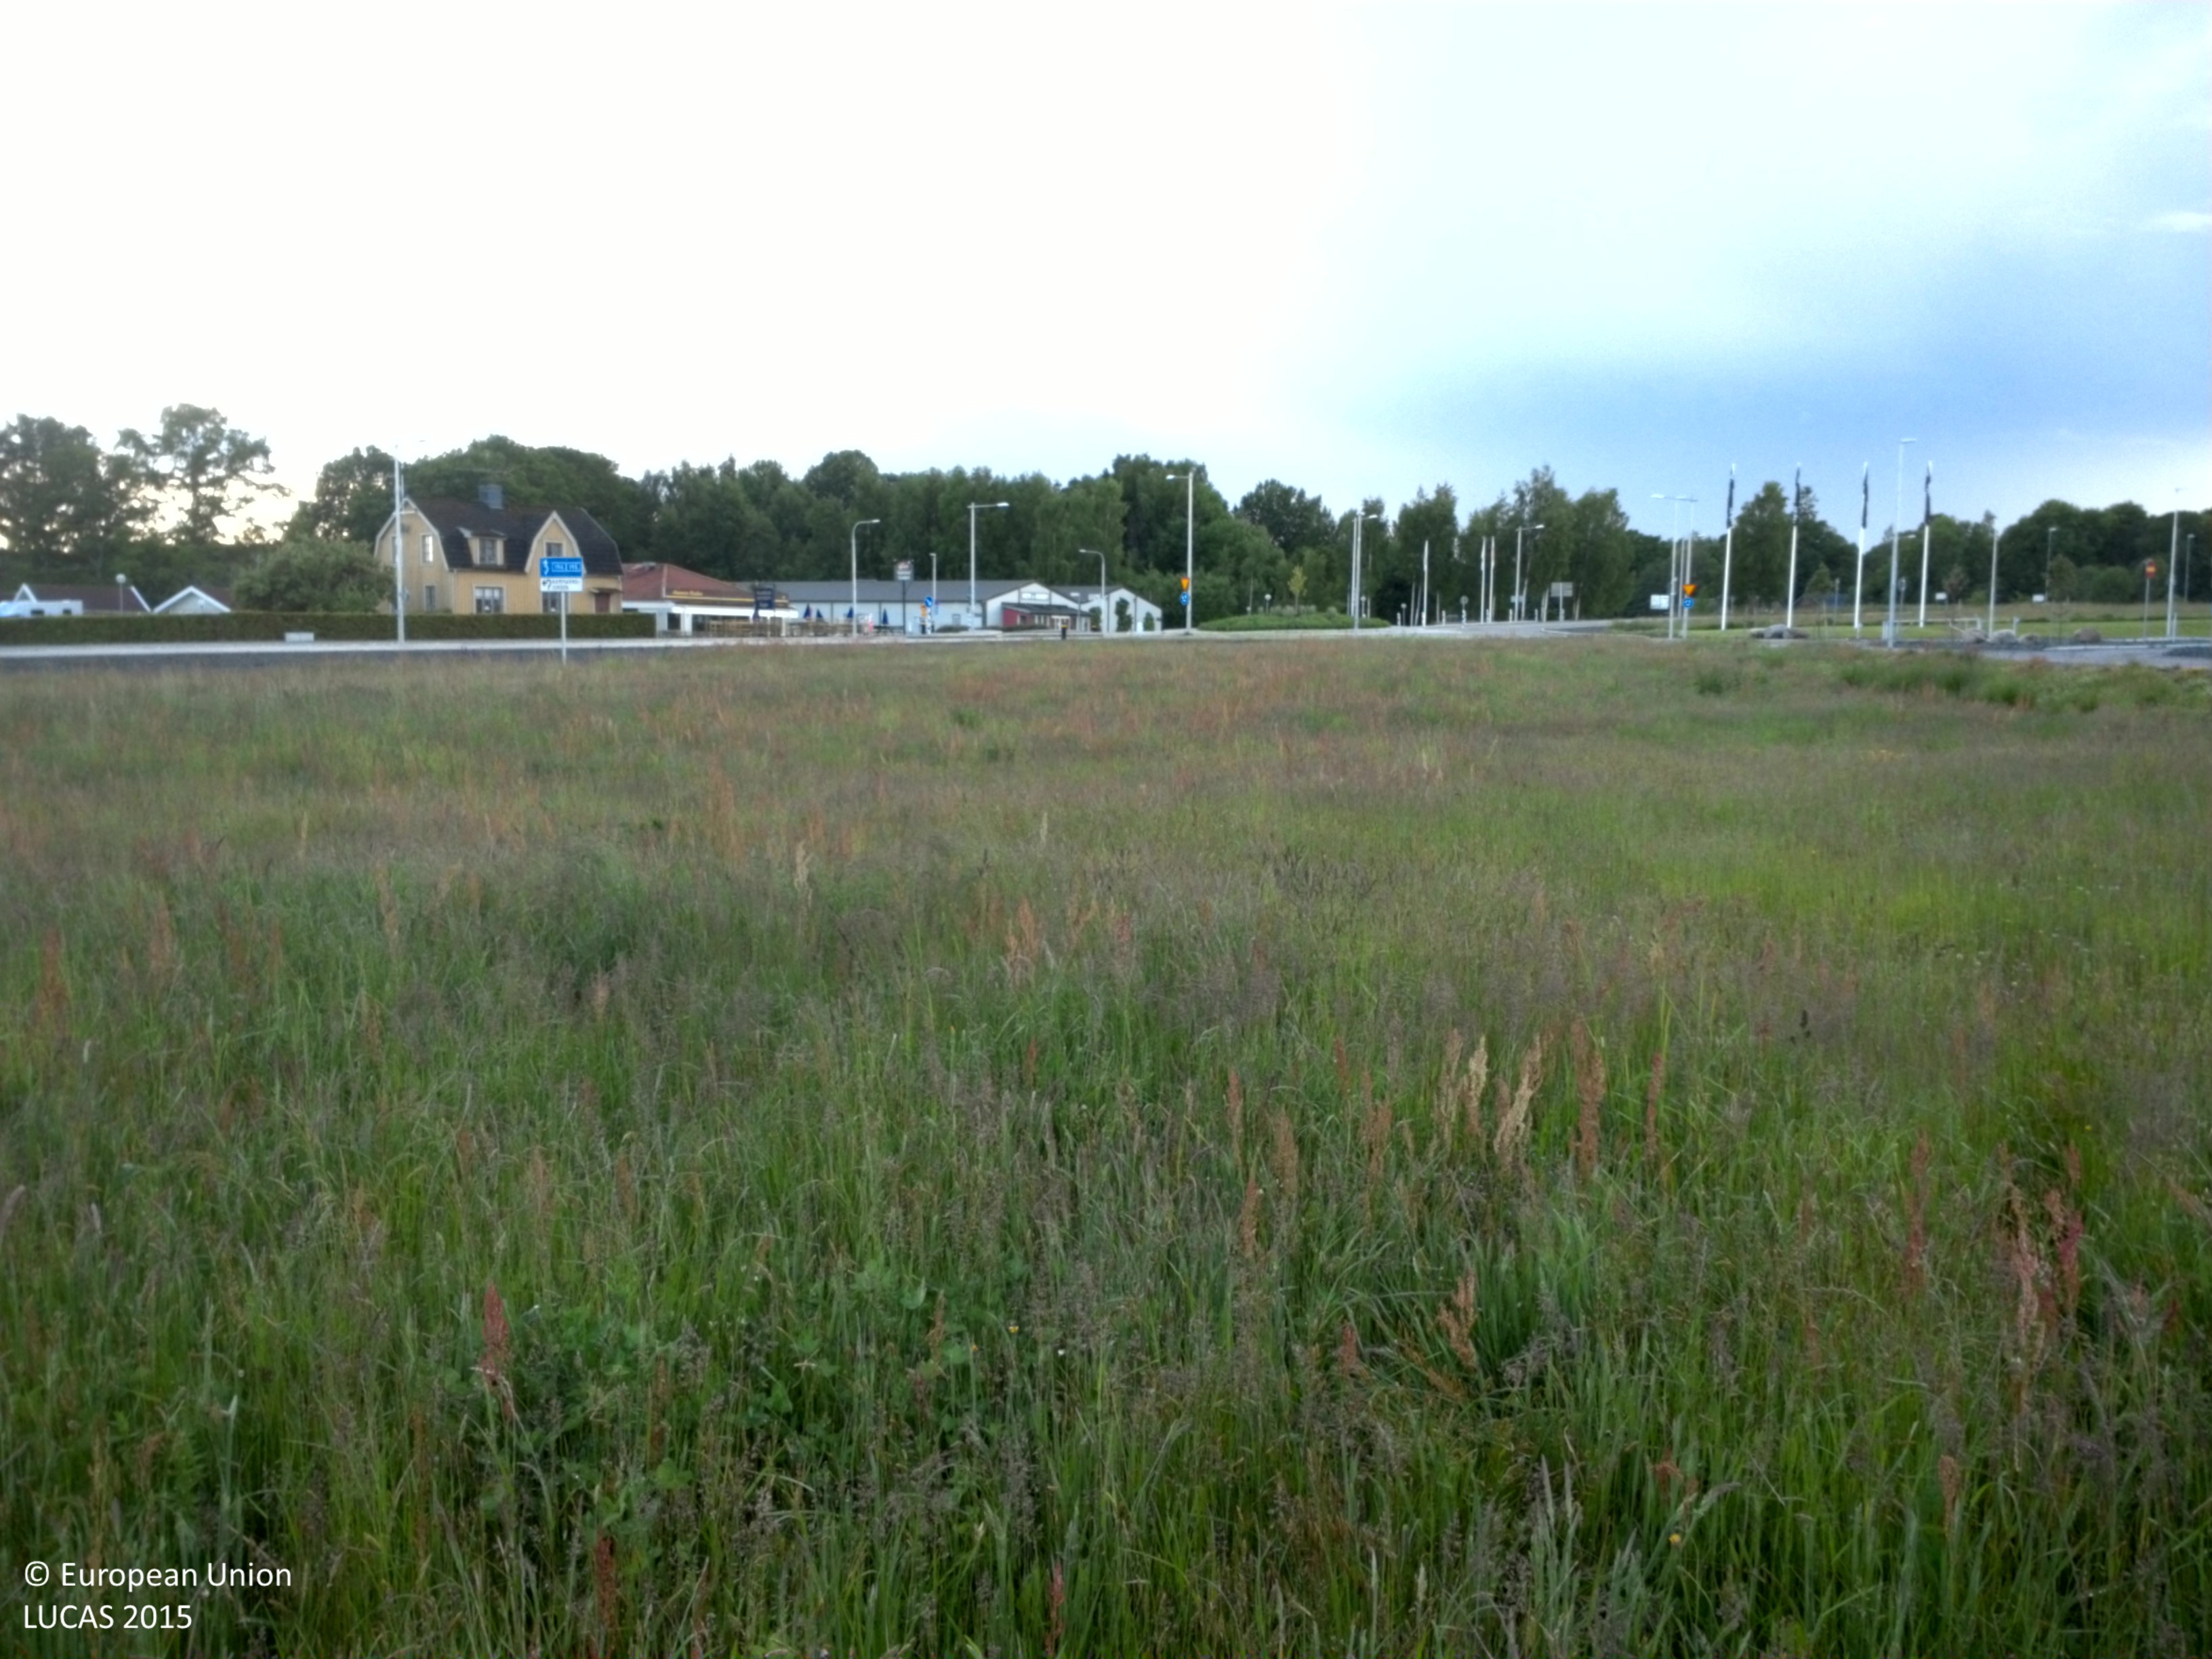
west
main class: Grassland
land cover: Grassland without tree/shrub cover
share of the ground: > 75 %
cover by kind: herbaceous plants 100 %
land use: Agriculture (excluding fallow land and kitchen gardens)
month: June
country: SE
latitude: 58.3136
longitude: 14.2782
